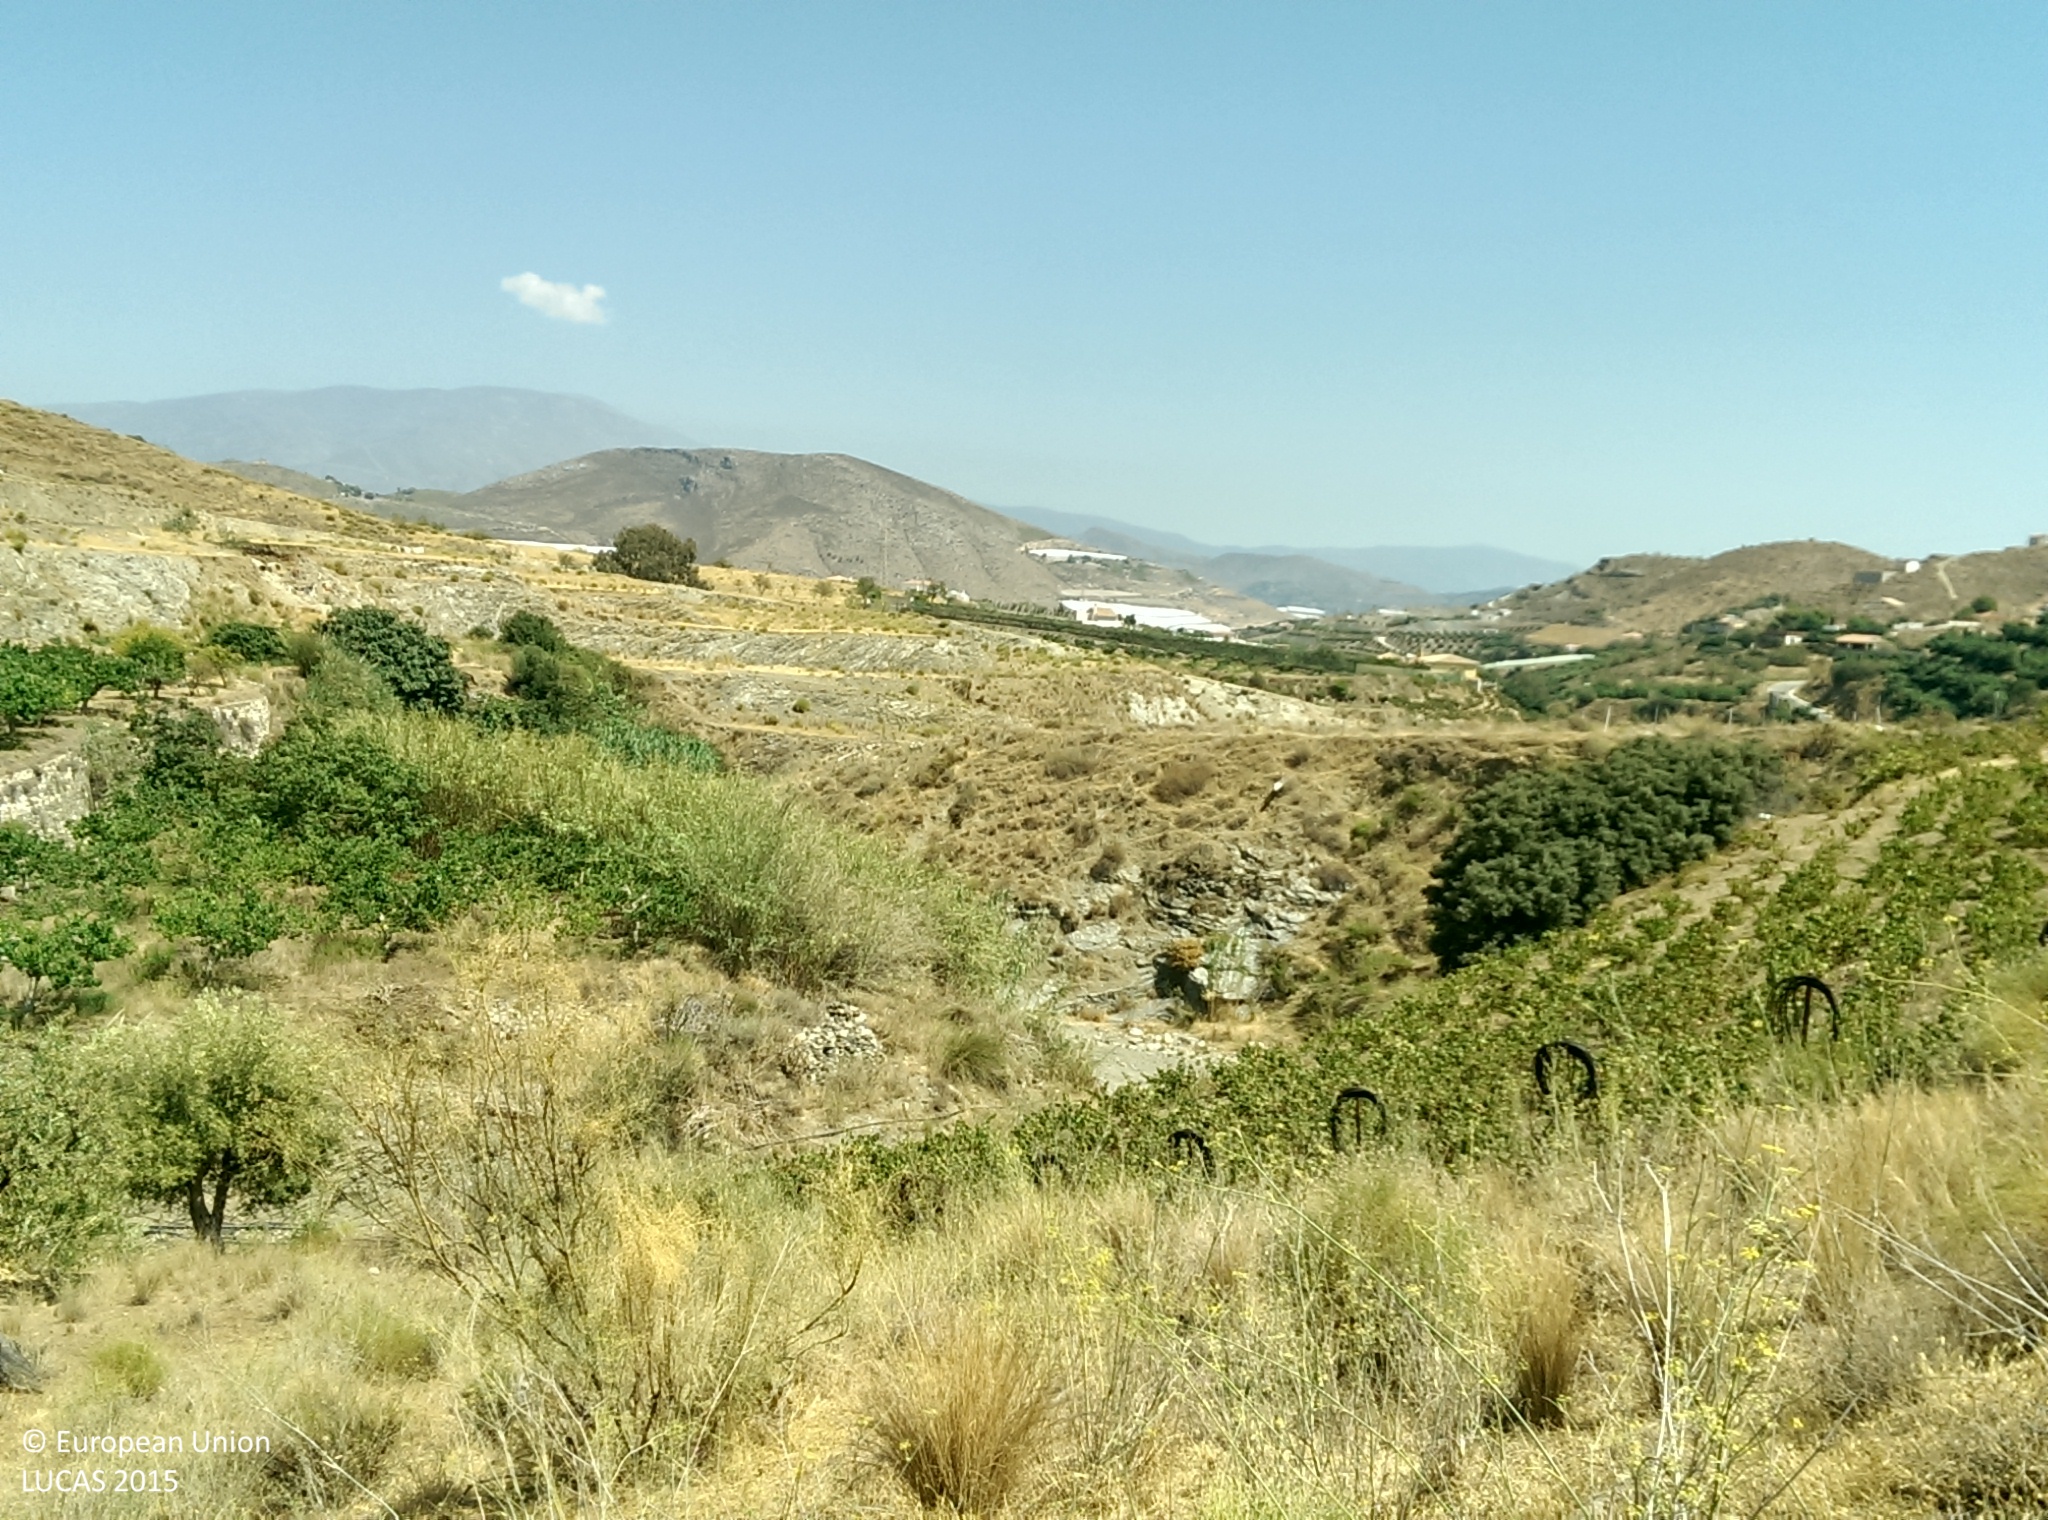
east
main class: Cropland
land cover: Nuts trees
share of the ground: 10 - 25 %
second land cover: Spontaneously vegetated surfaces
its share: 50 - 75 %
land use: Agriculture (excluding fallow land and kitchen gardens)
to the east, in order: Nuts trees; Spontaneously vegetated surfaces; Fences; Vineyards; Grassland with sparse tree/shrub cover; Rivers and streams; Grassland with sparse tree/shrub cover; Grassland without tree/shrub cover; Rivers and streams; Grass margins; Grassland without tree/shrub cover; Rivers and streams; Grassland with sparse tree/shrub cover; Grassland without tree/shrub cover; Tracks; Grassland without tree/shrub cover
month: August
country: ES
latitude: 36.7811
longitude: -3.6194
